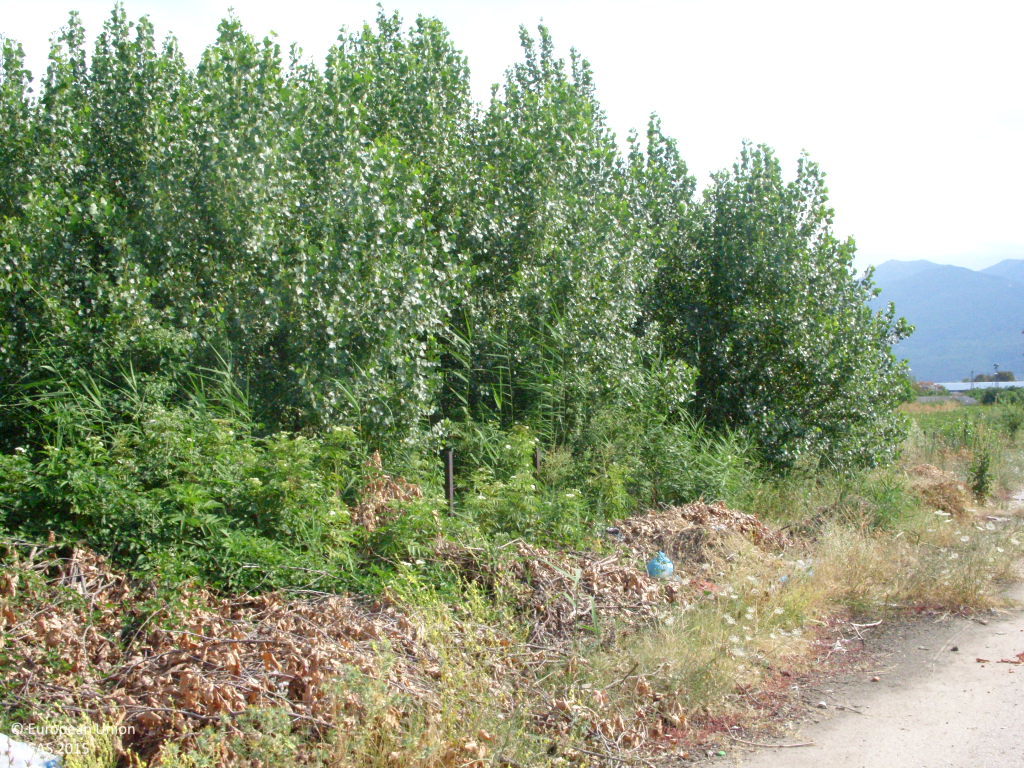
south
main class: Grassland
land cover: Grassland with sparse tree/shrub cover
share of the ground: > 75 %
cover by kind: herbaceous plants 90 %, broadleaved forest trees 5 %, shrubs 5 %
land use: Abandoned areas
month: July
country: BG
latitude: 42.2073
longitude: 24.1280
